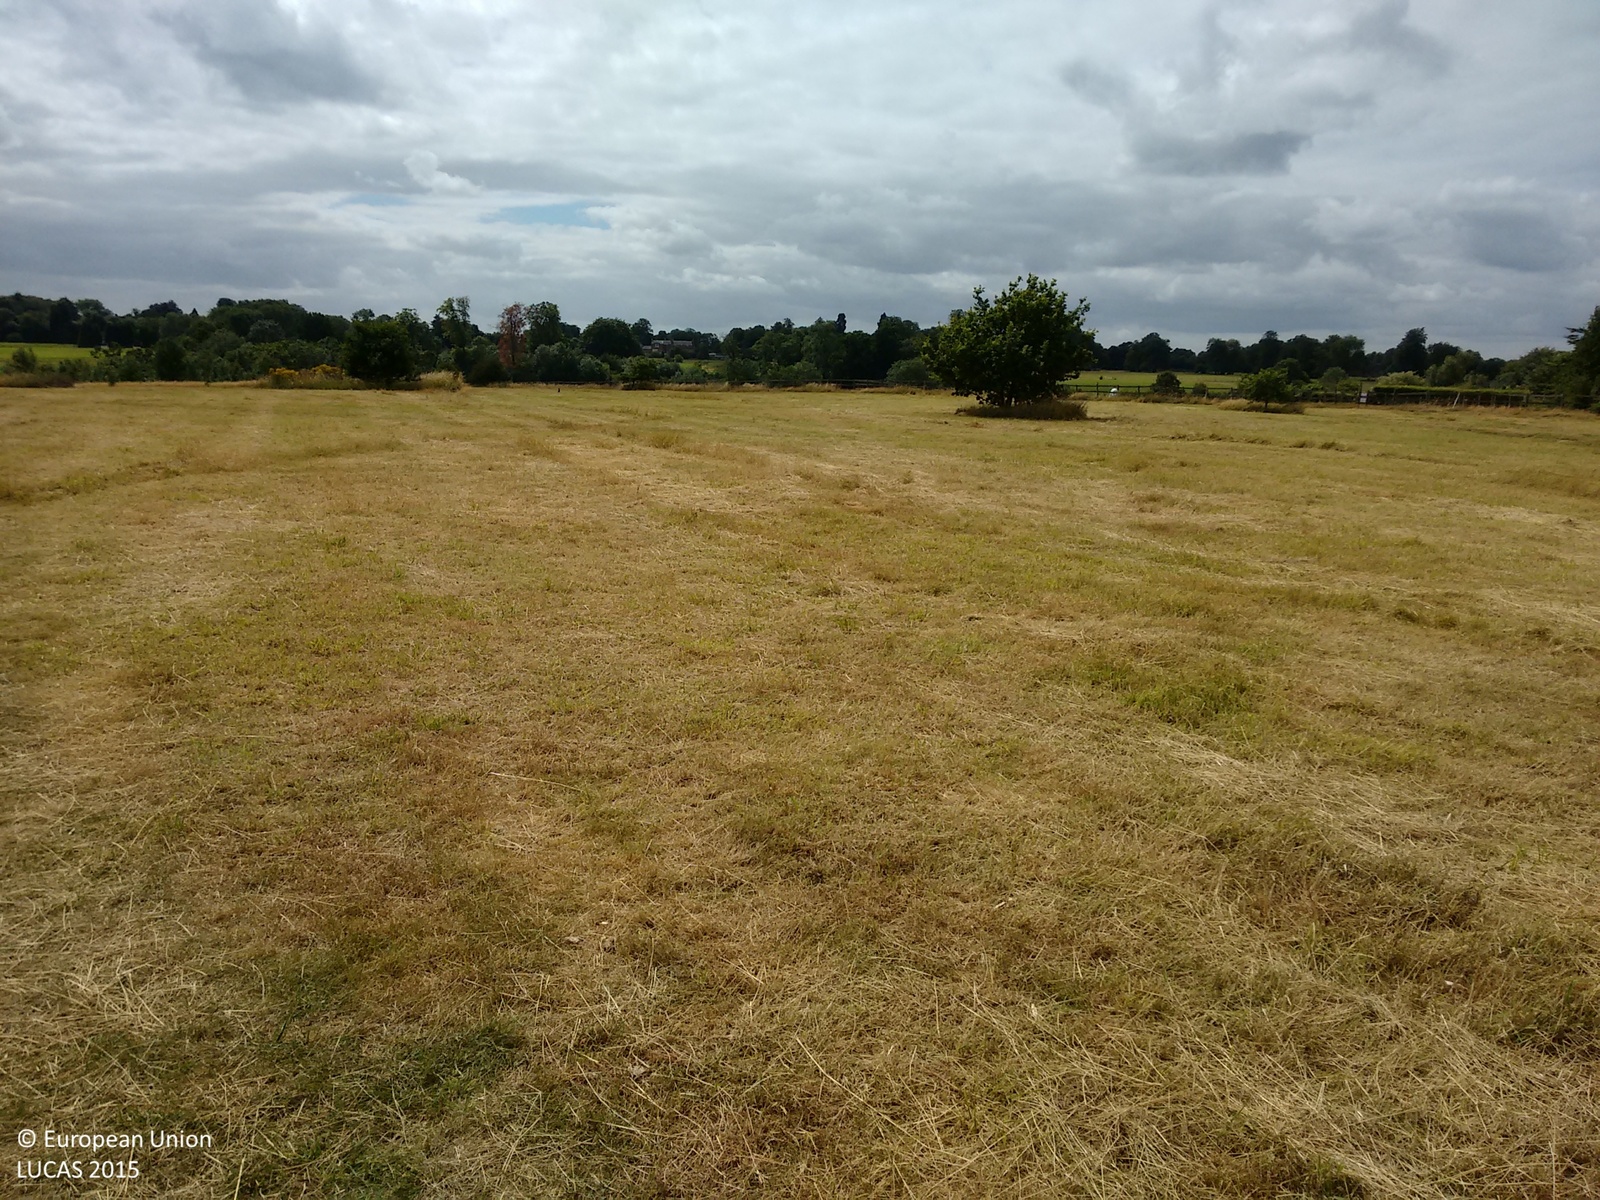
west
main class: Grassland
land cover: Grassland without tree/shrub cover
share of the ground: > 75 %
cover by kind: herbaceous plants 100 %
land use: Amenities, museums, leisure
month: August
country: GB
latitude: 51.3225
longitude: -0.1800
